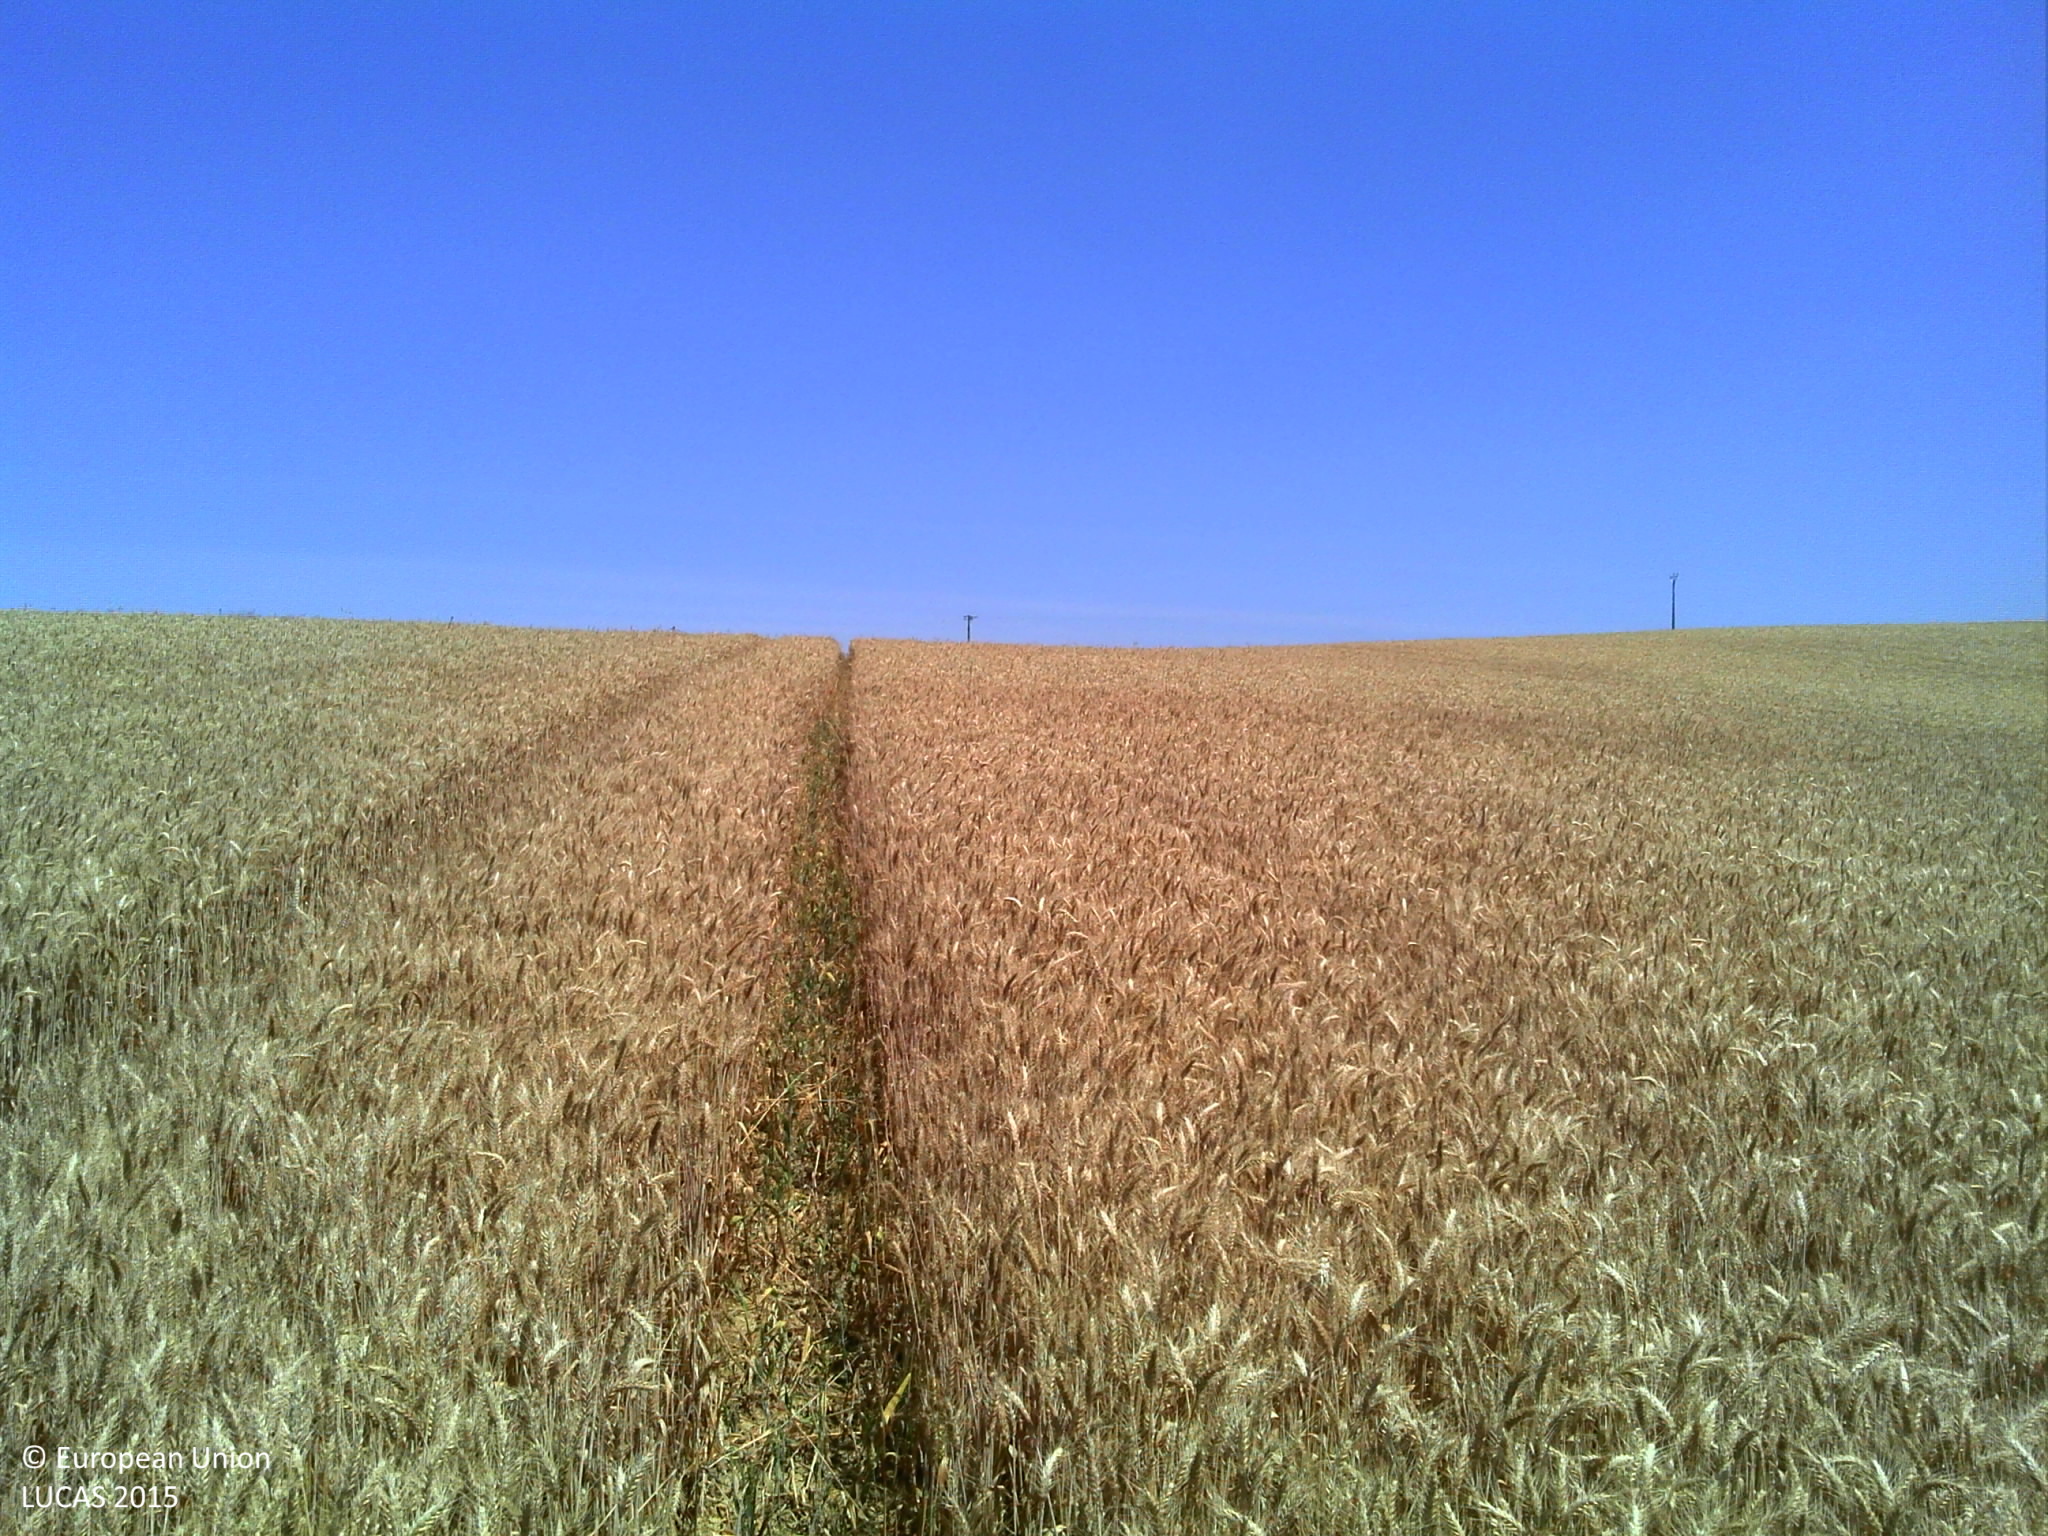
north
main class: Cropland
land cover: Common wheat
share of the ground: > 75 %
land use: Agriculture (excluding fallow land and kitchen gardens)
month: June
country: FR
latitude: 43.7745
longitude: 0.9670
